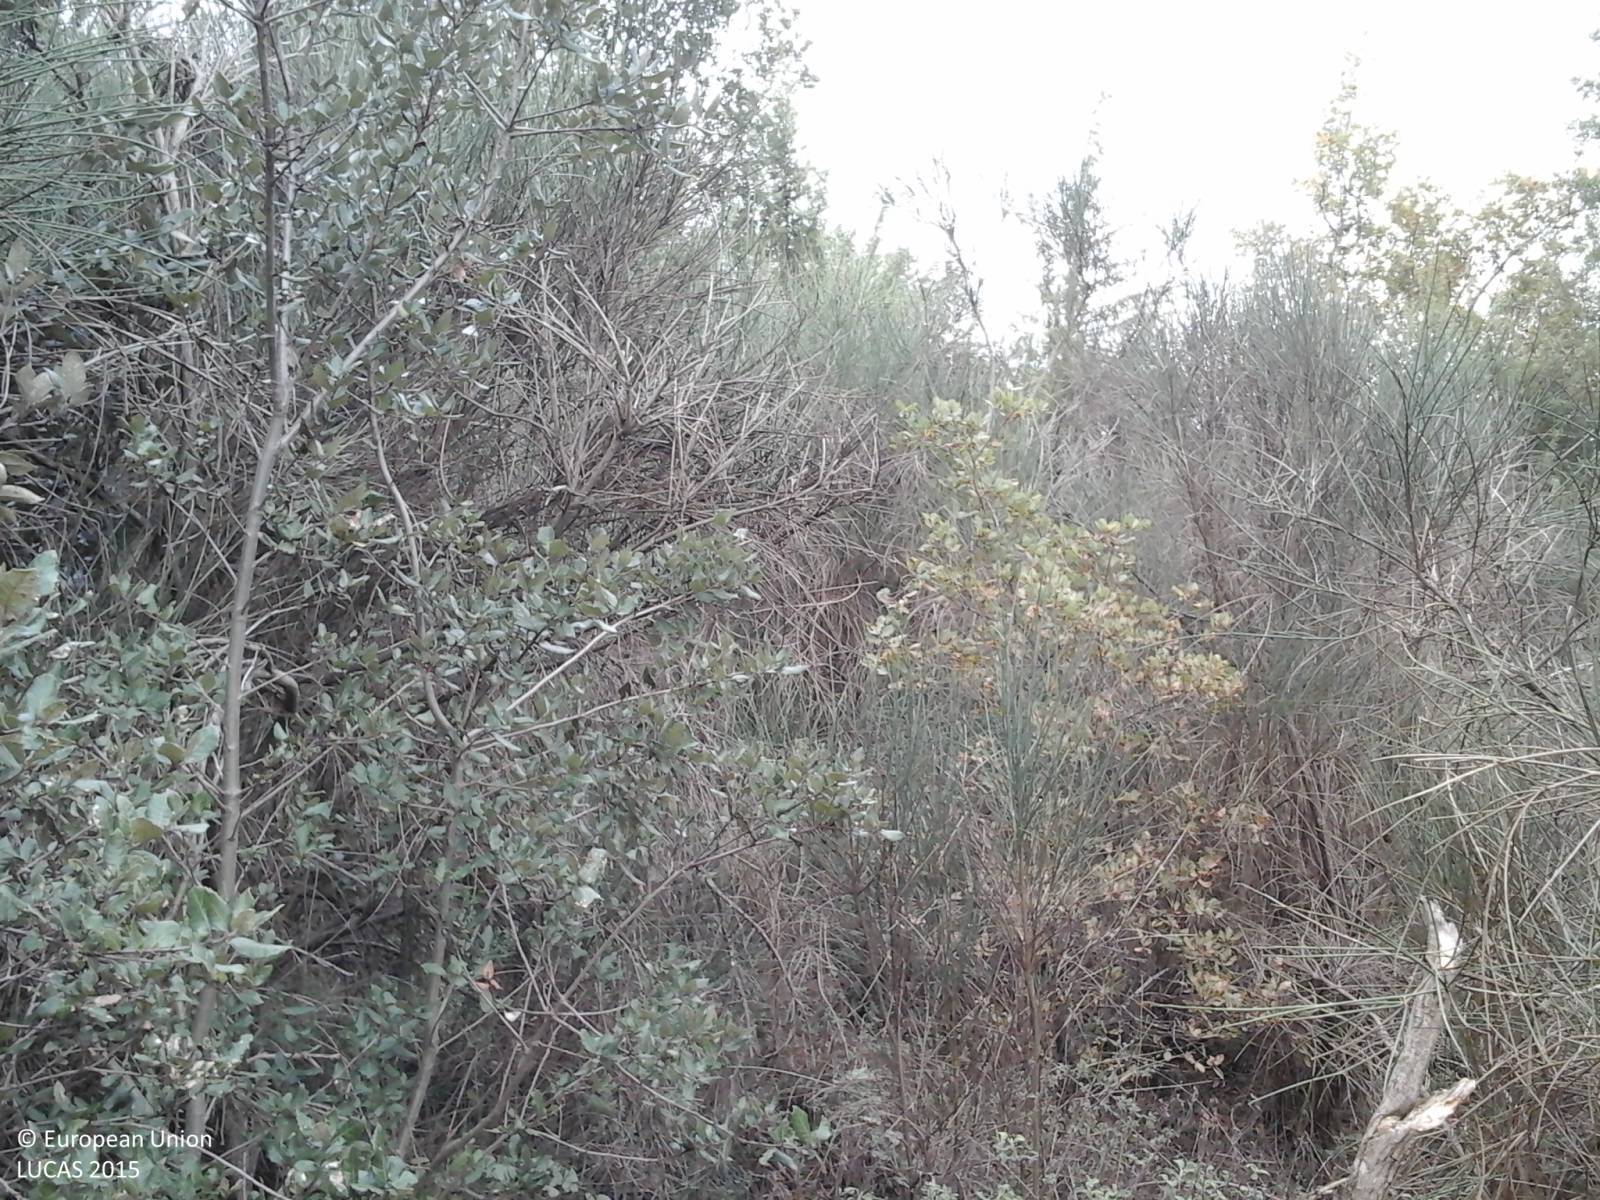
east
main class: Woodland
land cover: Broadleaved woodland
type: broadleaved evergreen forest
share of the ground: > 75 %
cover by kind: broadleaved forest trees 95 %, shrubs 5 %
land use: Forestry
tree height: > 5 m
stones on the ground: < 10 %
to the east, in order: Broadleaved woodland; Rivers and streams; Broadleaved woodland; Olive groves; Broadleaved woodland; Olive groves
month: October
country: IT
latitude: 42.7209
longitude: 12.1789
